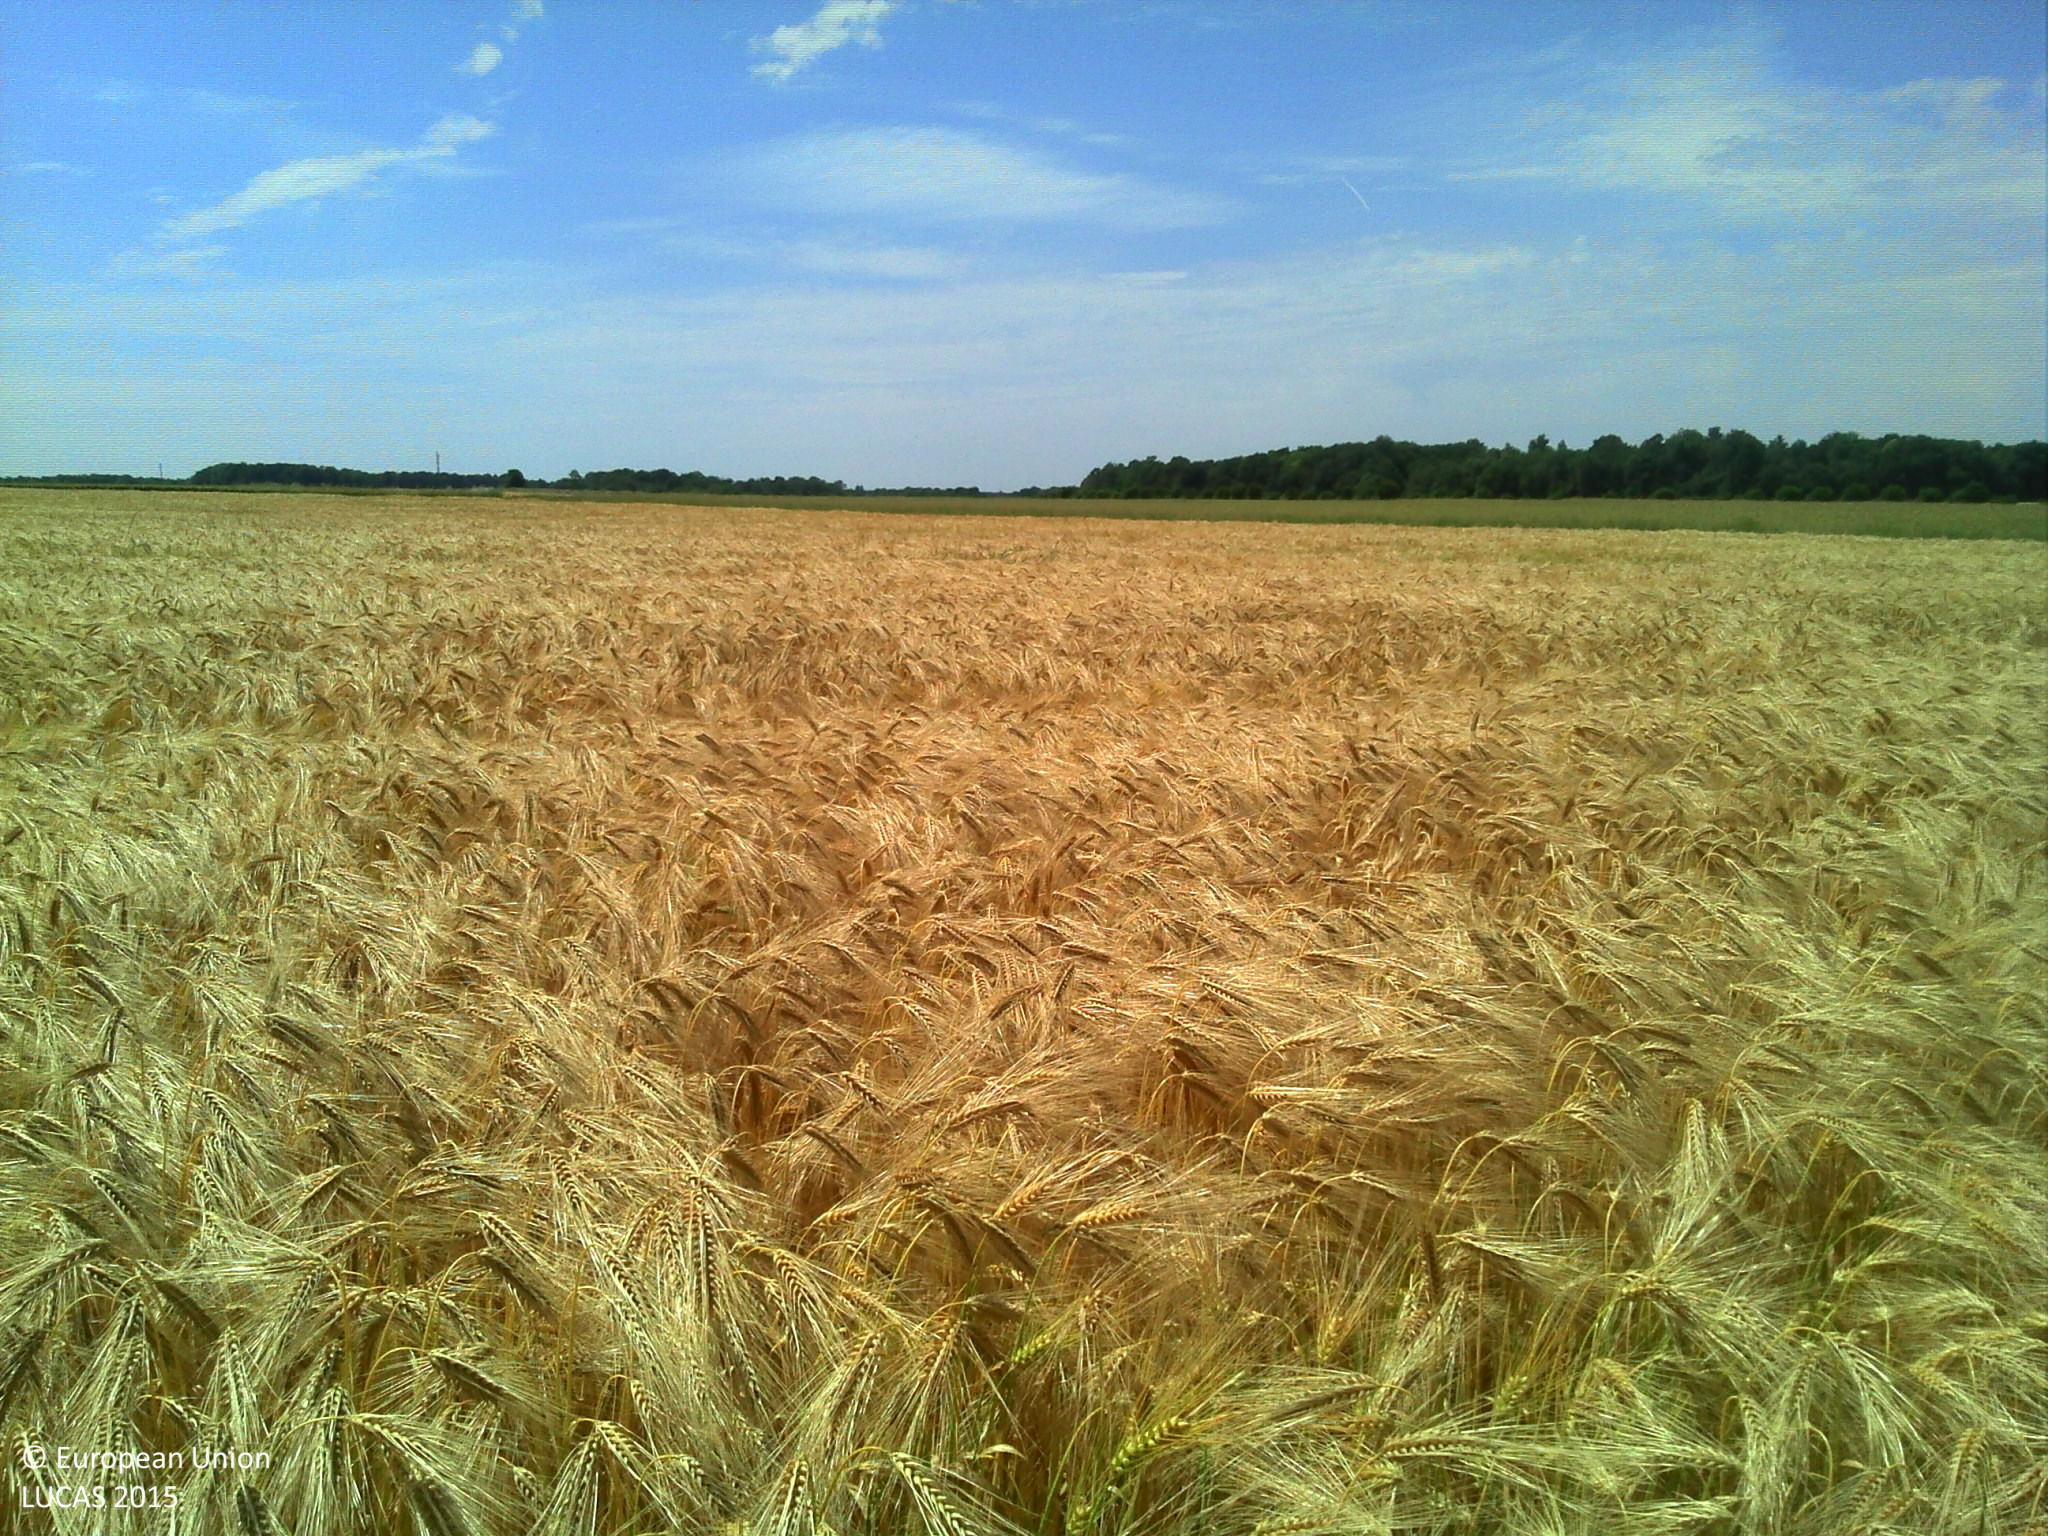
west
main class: Cropland
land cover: Barley
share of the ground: > 75 %
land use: Agriculture (excluding fallow land and kitchen gardens)
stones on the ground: 10 - 25 %
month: June
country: FR
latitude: 49.1017
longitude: 1.2002
